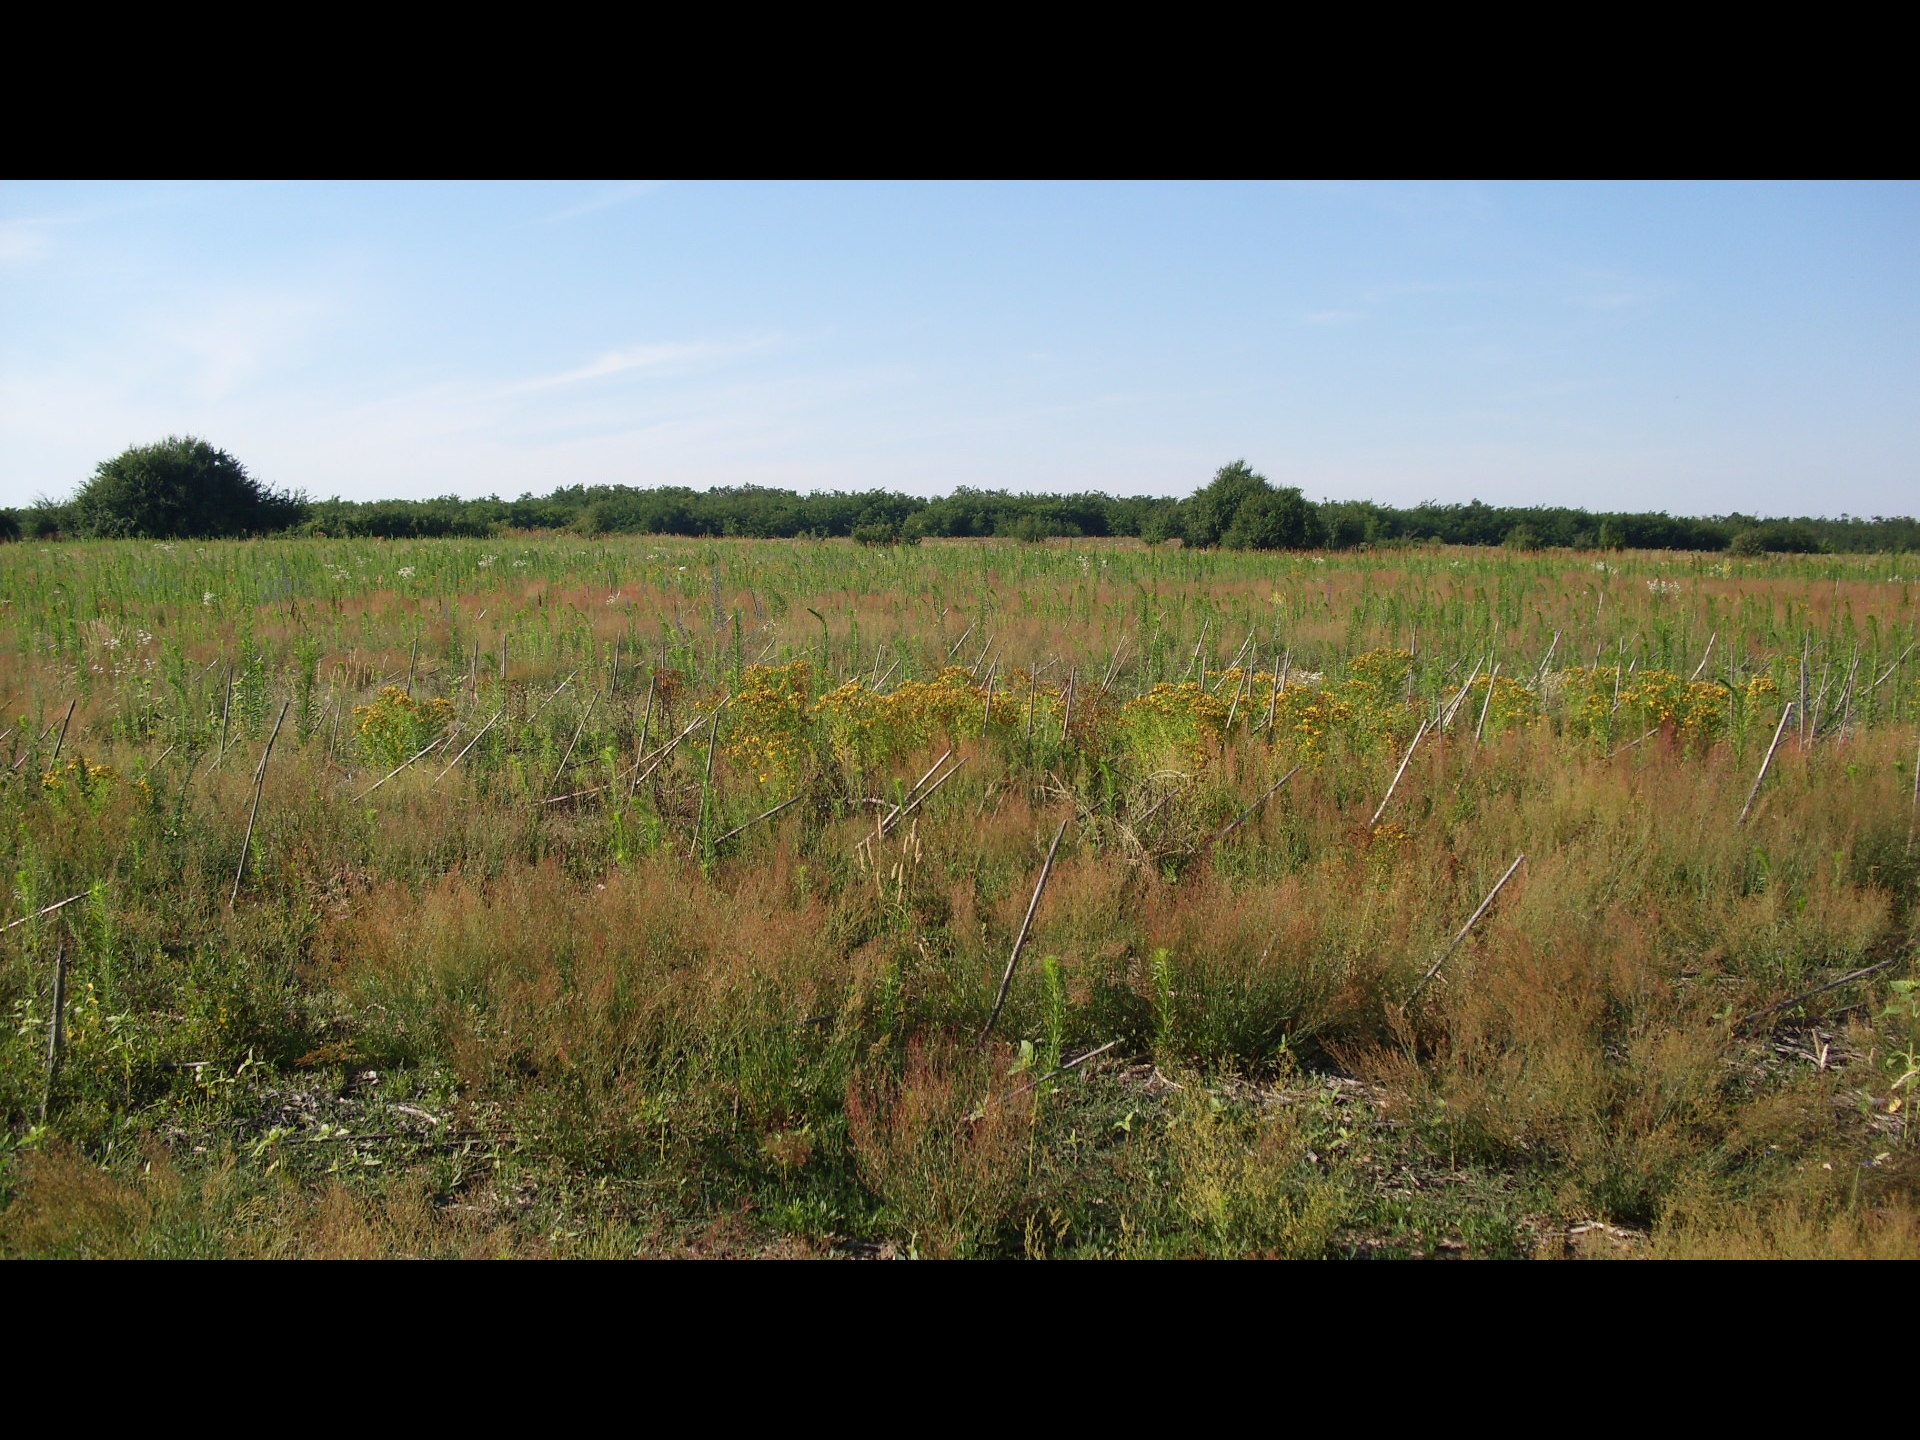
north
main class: Grassland
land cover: Spontaneously vegetated surfaces
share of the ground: > 75 %
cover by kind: herbaceous plants 85 %, unconsolidated bare surface 15 %
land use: Fallow land
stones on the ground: < 10 %
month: June
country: BG
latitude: 43.5642
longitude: 23.1510
